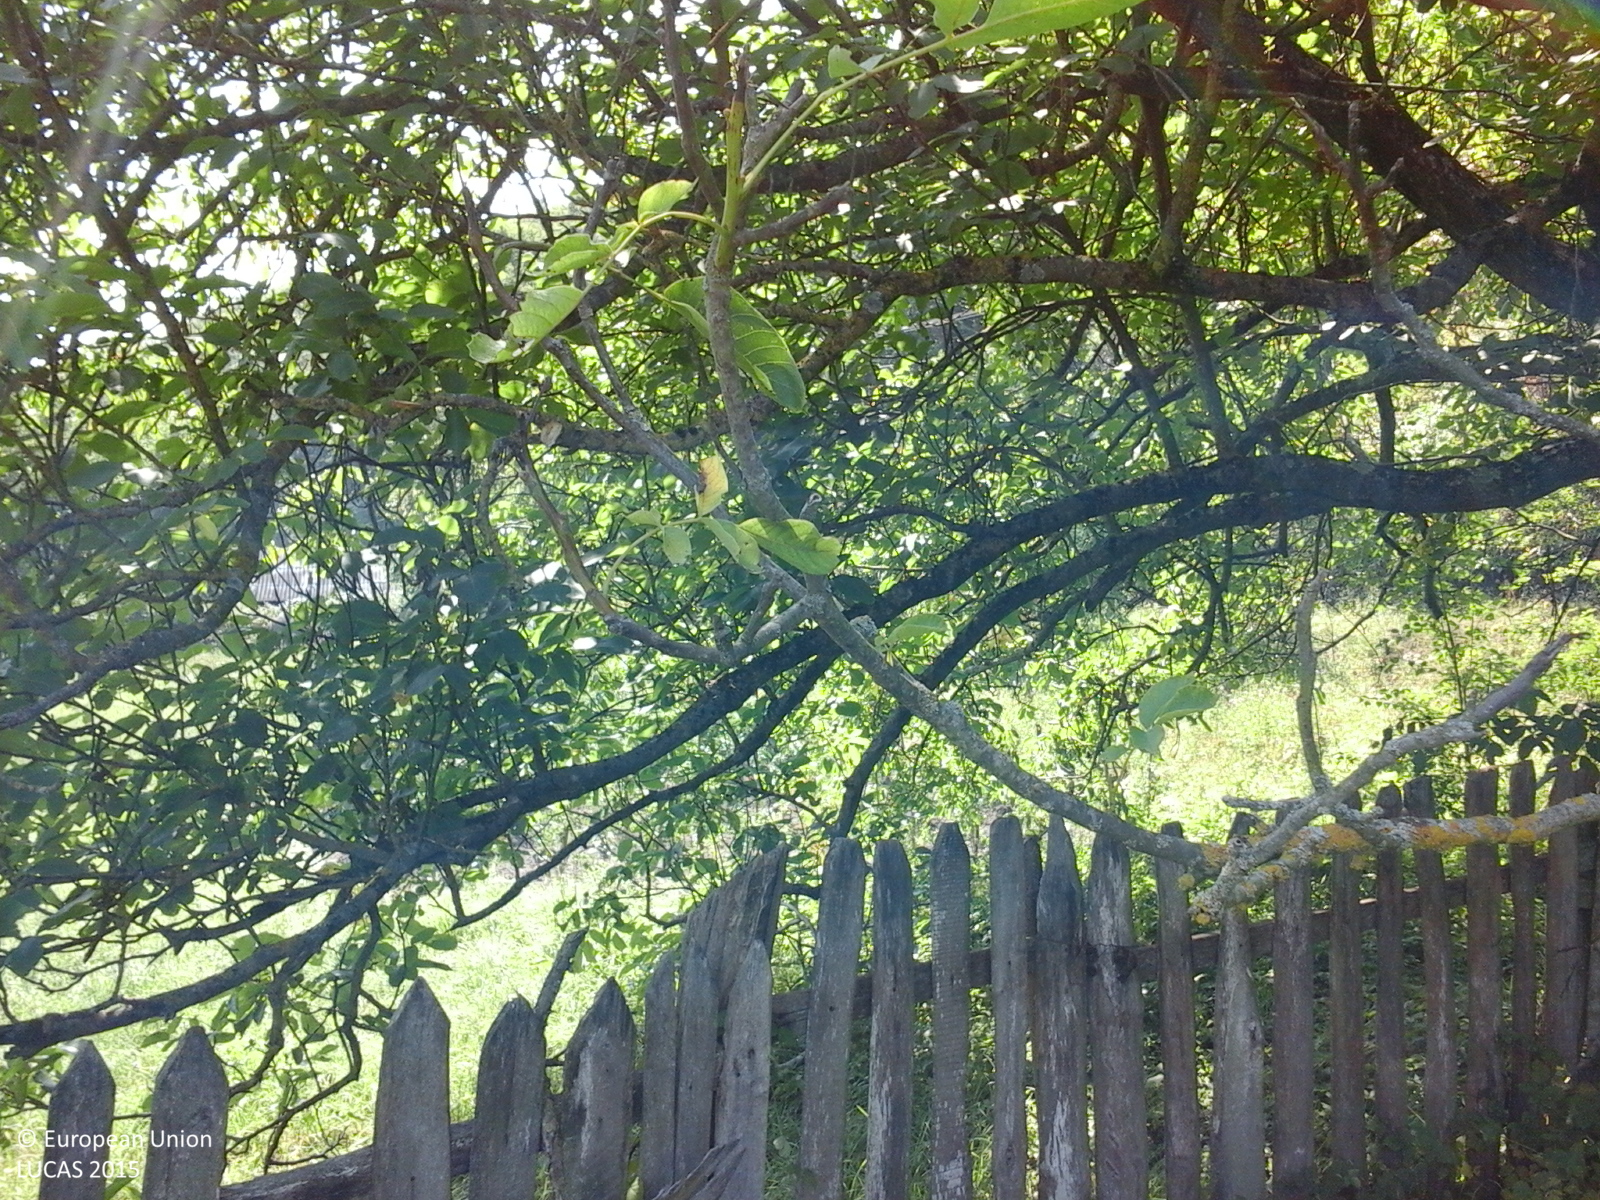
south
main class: Grassland
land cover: Grassland with sparse tree/shrub cover
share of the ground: > 75 %
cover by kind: herbaceous plants 85 %, shrubs 10 %, broadleaved forest trees 5 %
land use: Fallow land
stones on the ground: 10 - 25 %
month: August
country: RO
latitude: 46.2448
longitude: 22.0930
